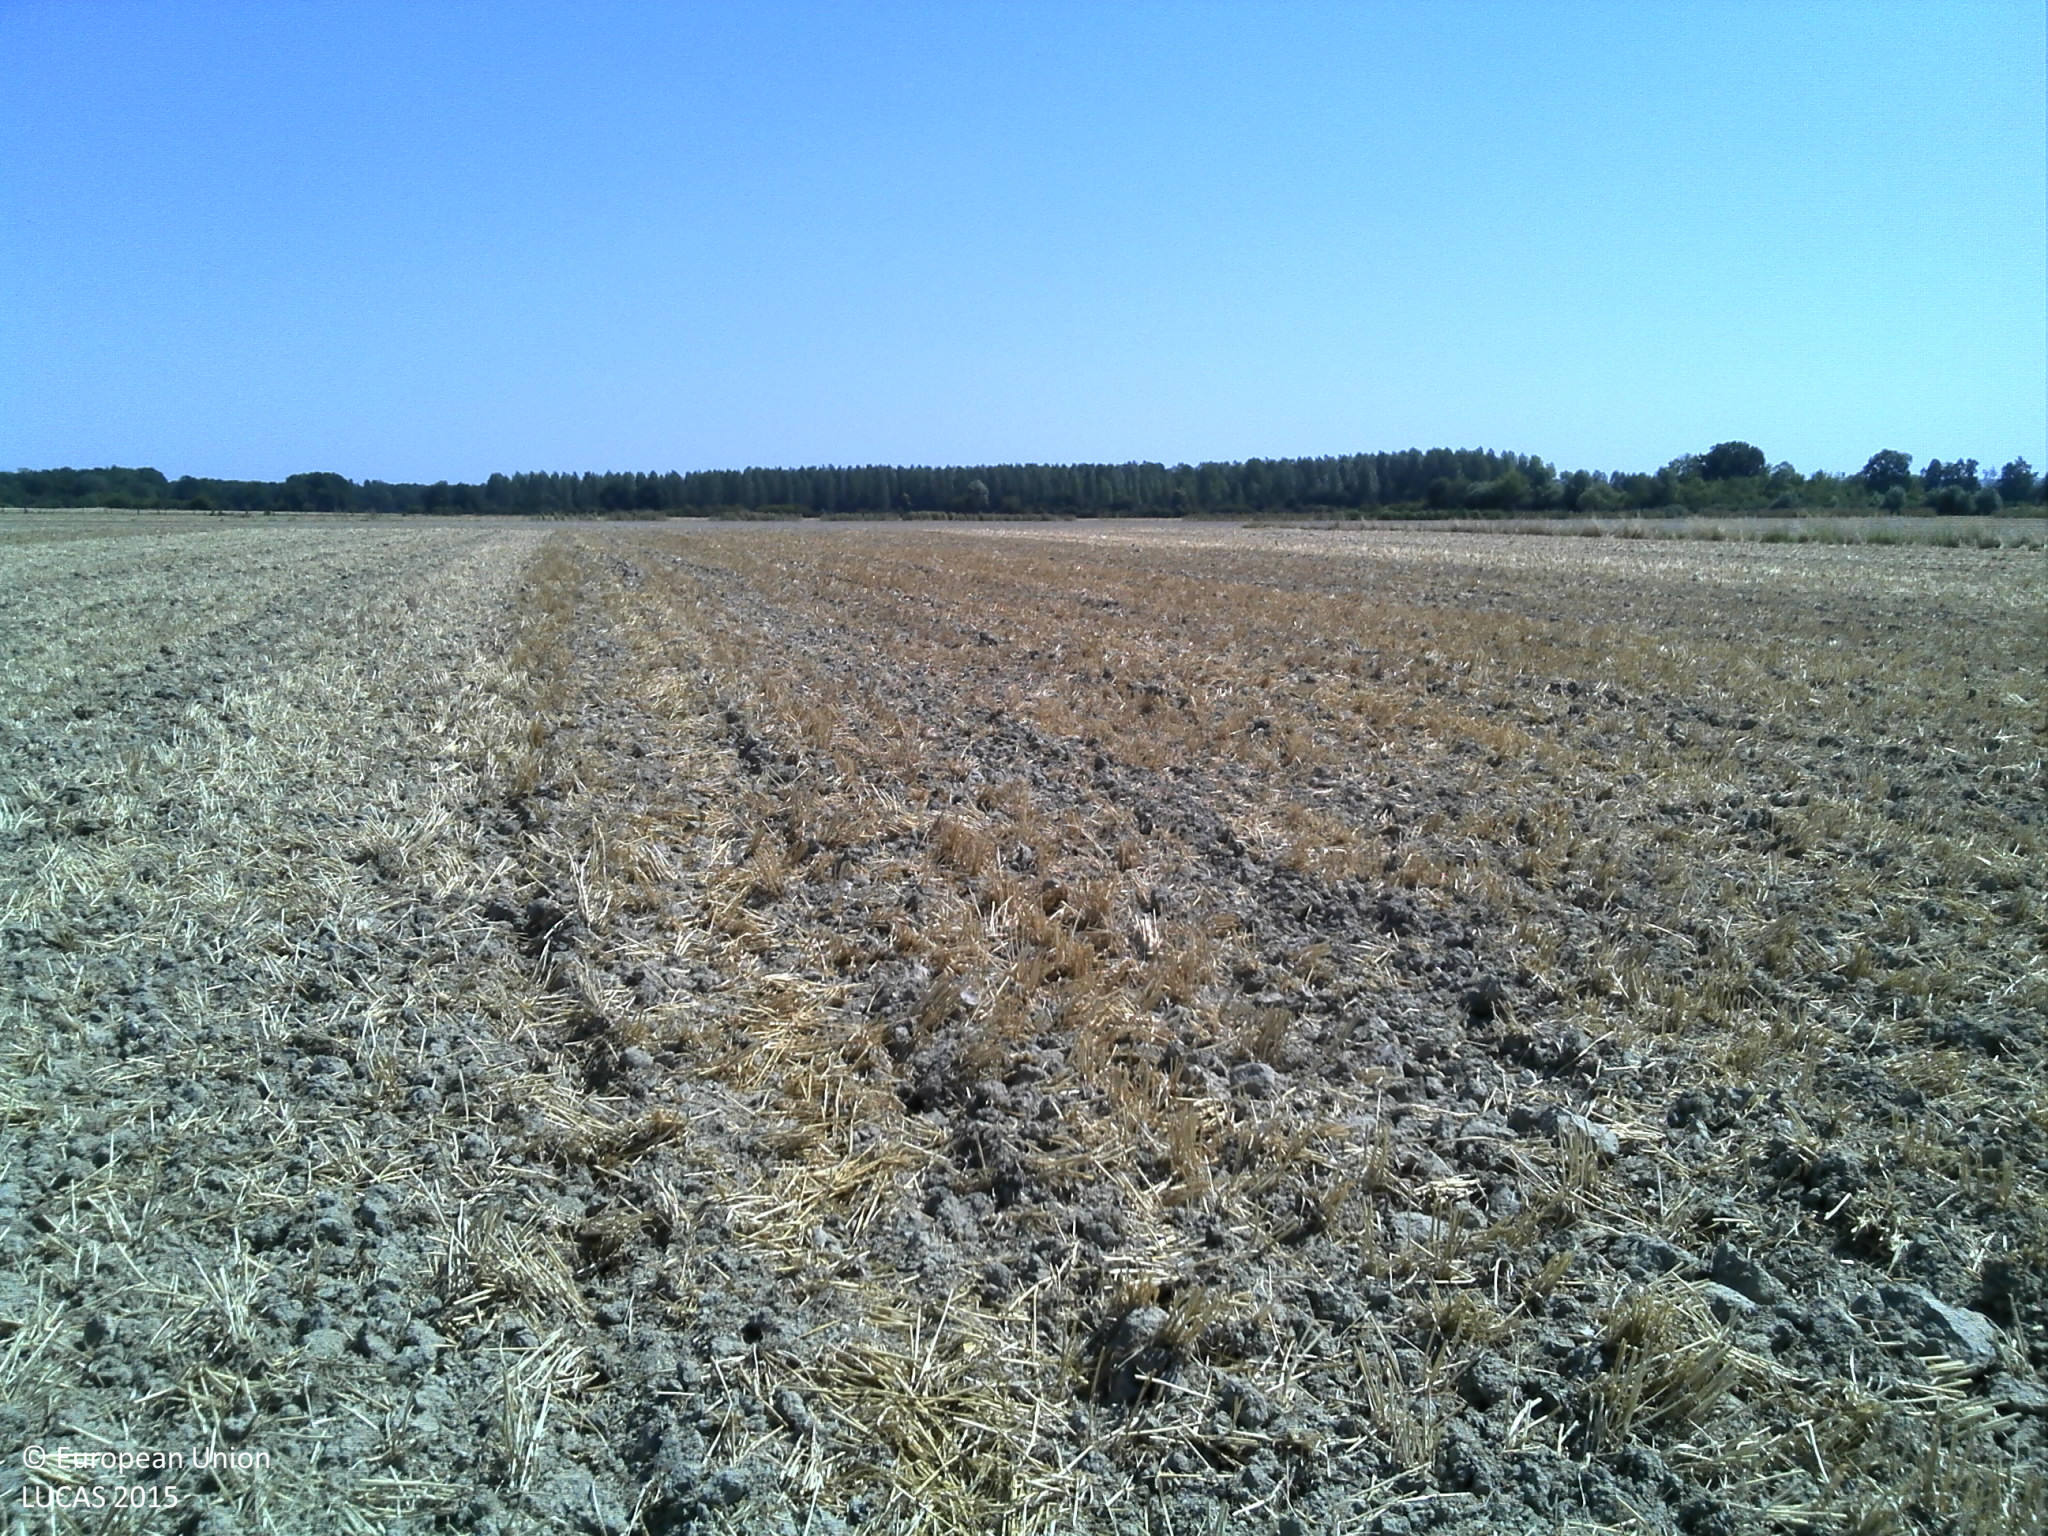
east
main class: Cropland
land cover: Common wheat
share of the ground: > 75 %
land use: Agriculture (excluding fallow land and kitchen gardens)
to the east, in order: Common wheat; Ditches and canals; Sugar beet; Ditches and canals; Common wheat
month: August
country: FR
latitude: 49.2350
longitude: 4.7646
